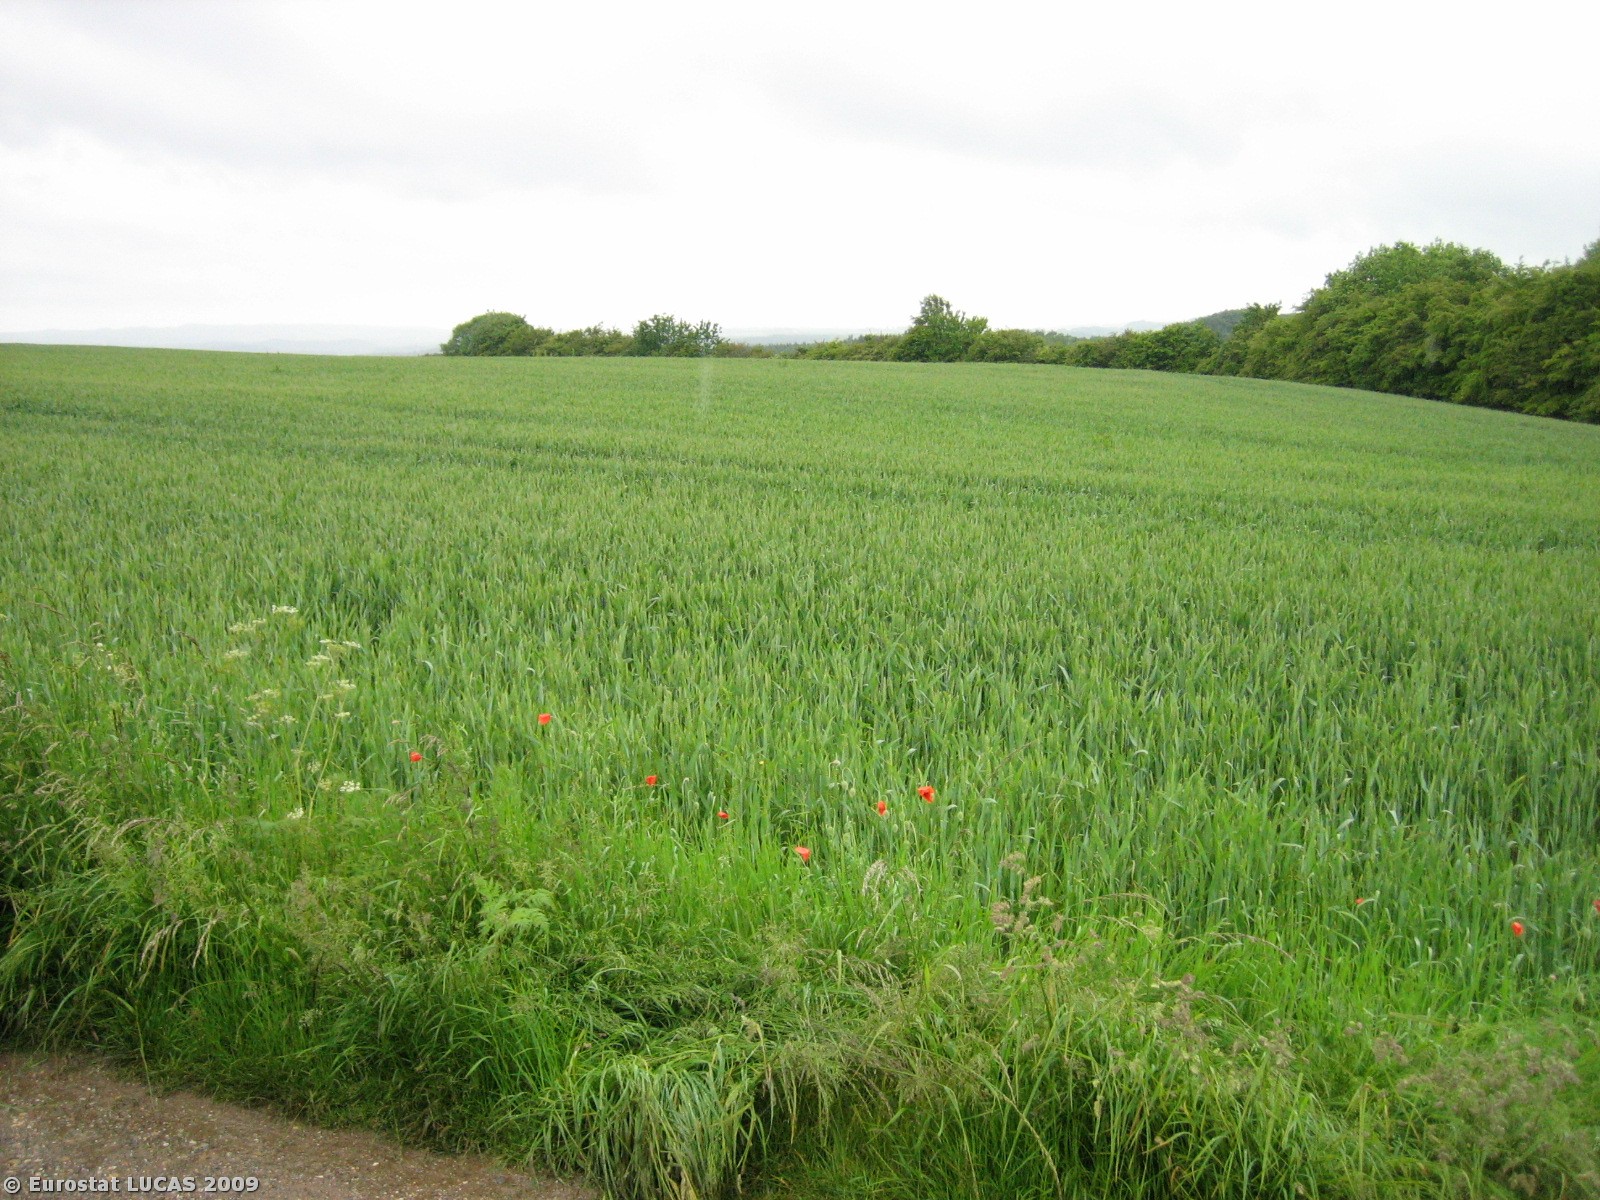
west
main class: Cropland
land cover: Common wheat
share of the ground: > 75 %
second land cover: Barley
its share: < 10 %
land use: Agriculture (excluding fallow land and kitchen gardens)
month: June
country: DK
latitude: 56.0260
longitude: 9.9840
